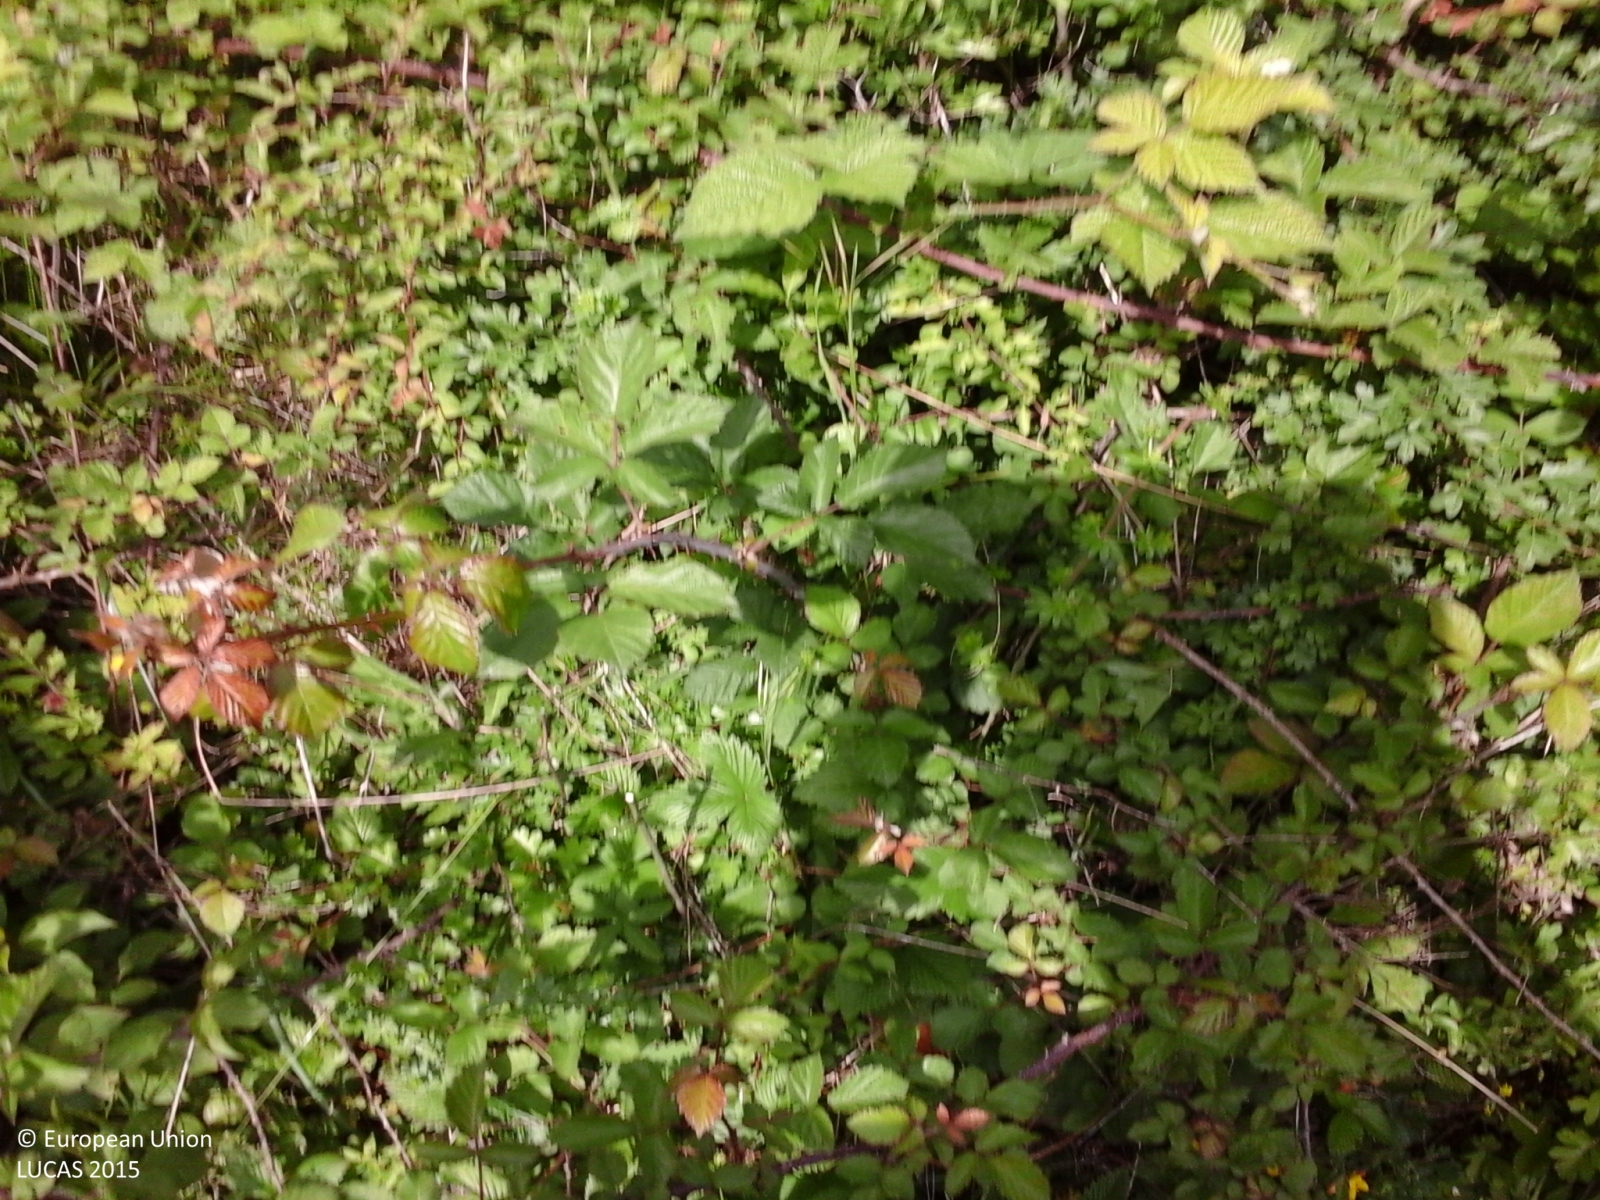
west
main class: Shrubland
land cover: Shrubland with sparse tree cover
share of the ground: 50 - 75 %
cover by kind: shrubs 90 %, broadleaved forest trees 5 %, herbaceous plants 5 %
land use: Forestry
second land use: Agriculture (excluding fallow land and kitchen gardens)
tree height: < 5 m
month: May
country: IT
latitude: 41.8628
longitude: 13.1809
